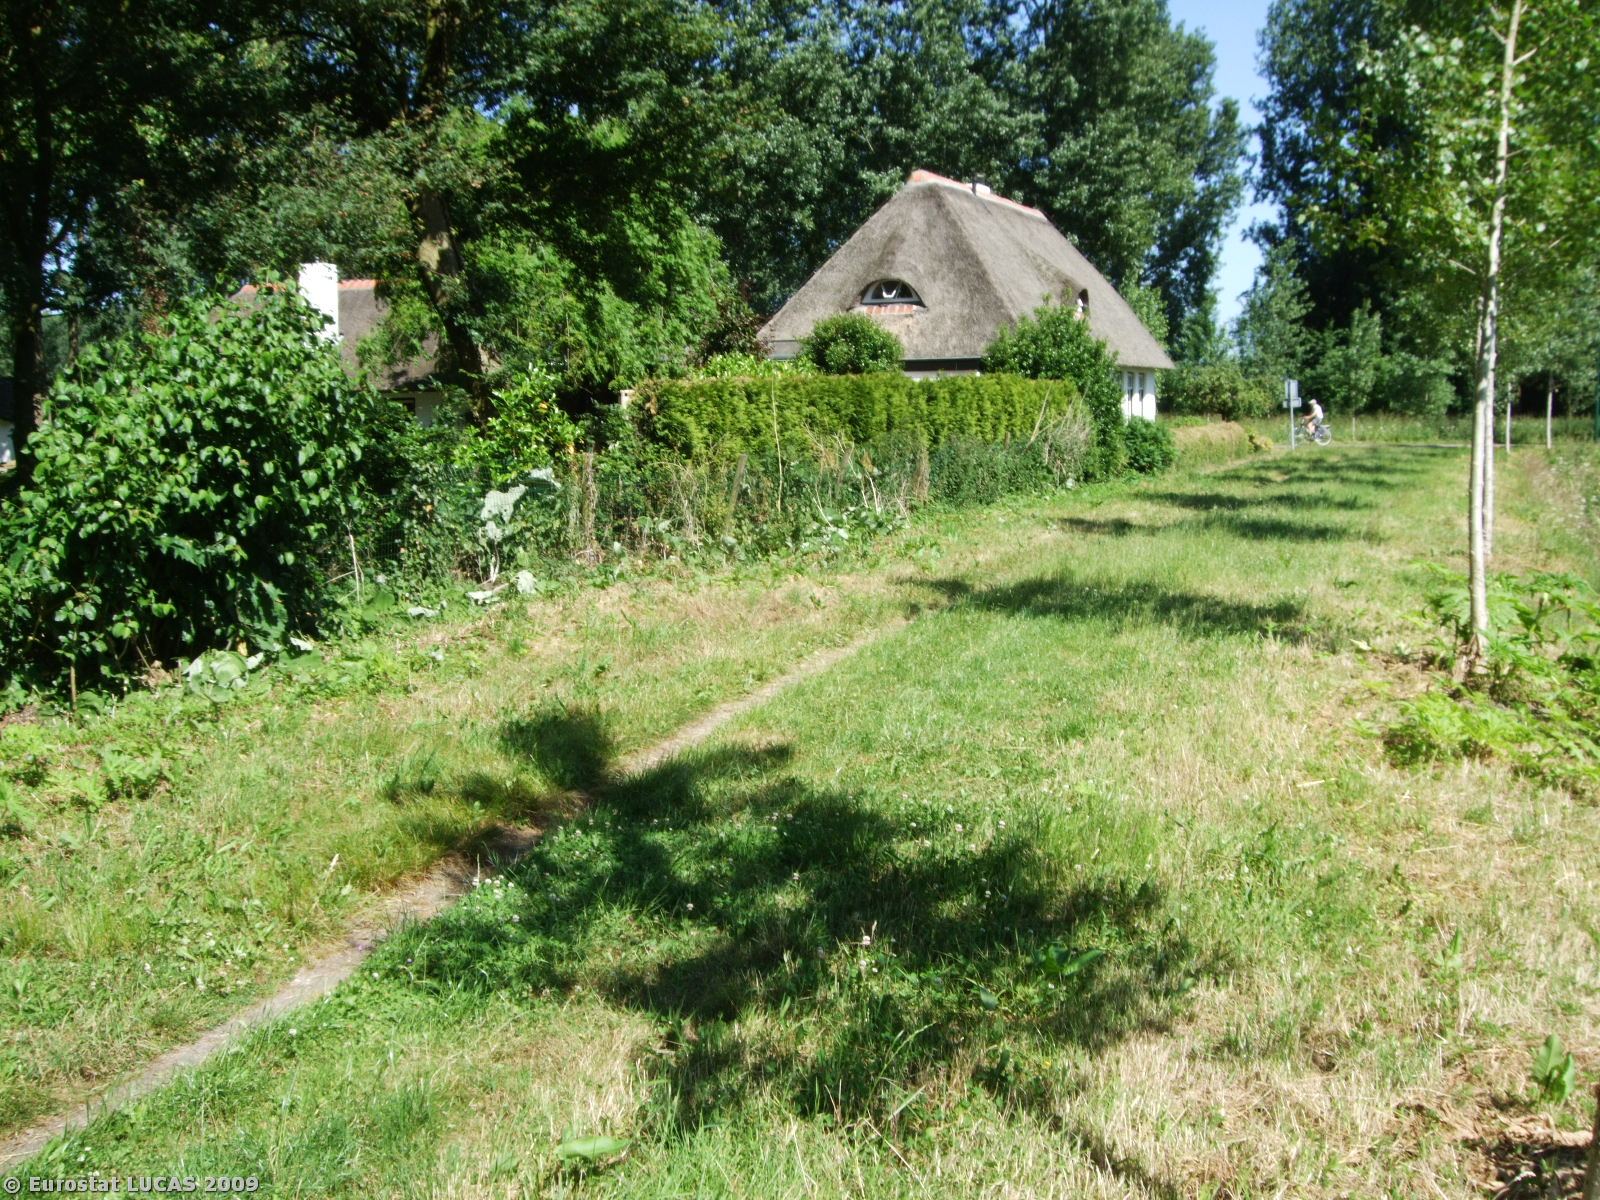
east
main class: Grassland
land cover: Grassland with sparse tree/shrub cover
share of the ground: > 75 %
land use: Road transport
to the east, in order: Grassland with sparse tree/shrub cover; Artificial constructions in urban areas; Grass margins; Paved roads, cycling and walking lanes; Lines of trees; Grass margins; Ditches and canals; Lines of trees; Fences; Grassland with sparse tree/shrub cover; Broadleaved woodland; Grassland without tree/shrub cover; Ditches and canals; Grassland without tree/shrub cover
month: June
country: NL
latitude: 51.5523
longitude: 5.4551
